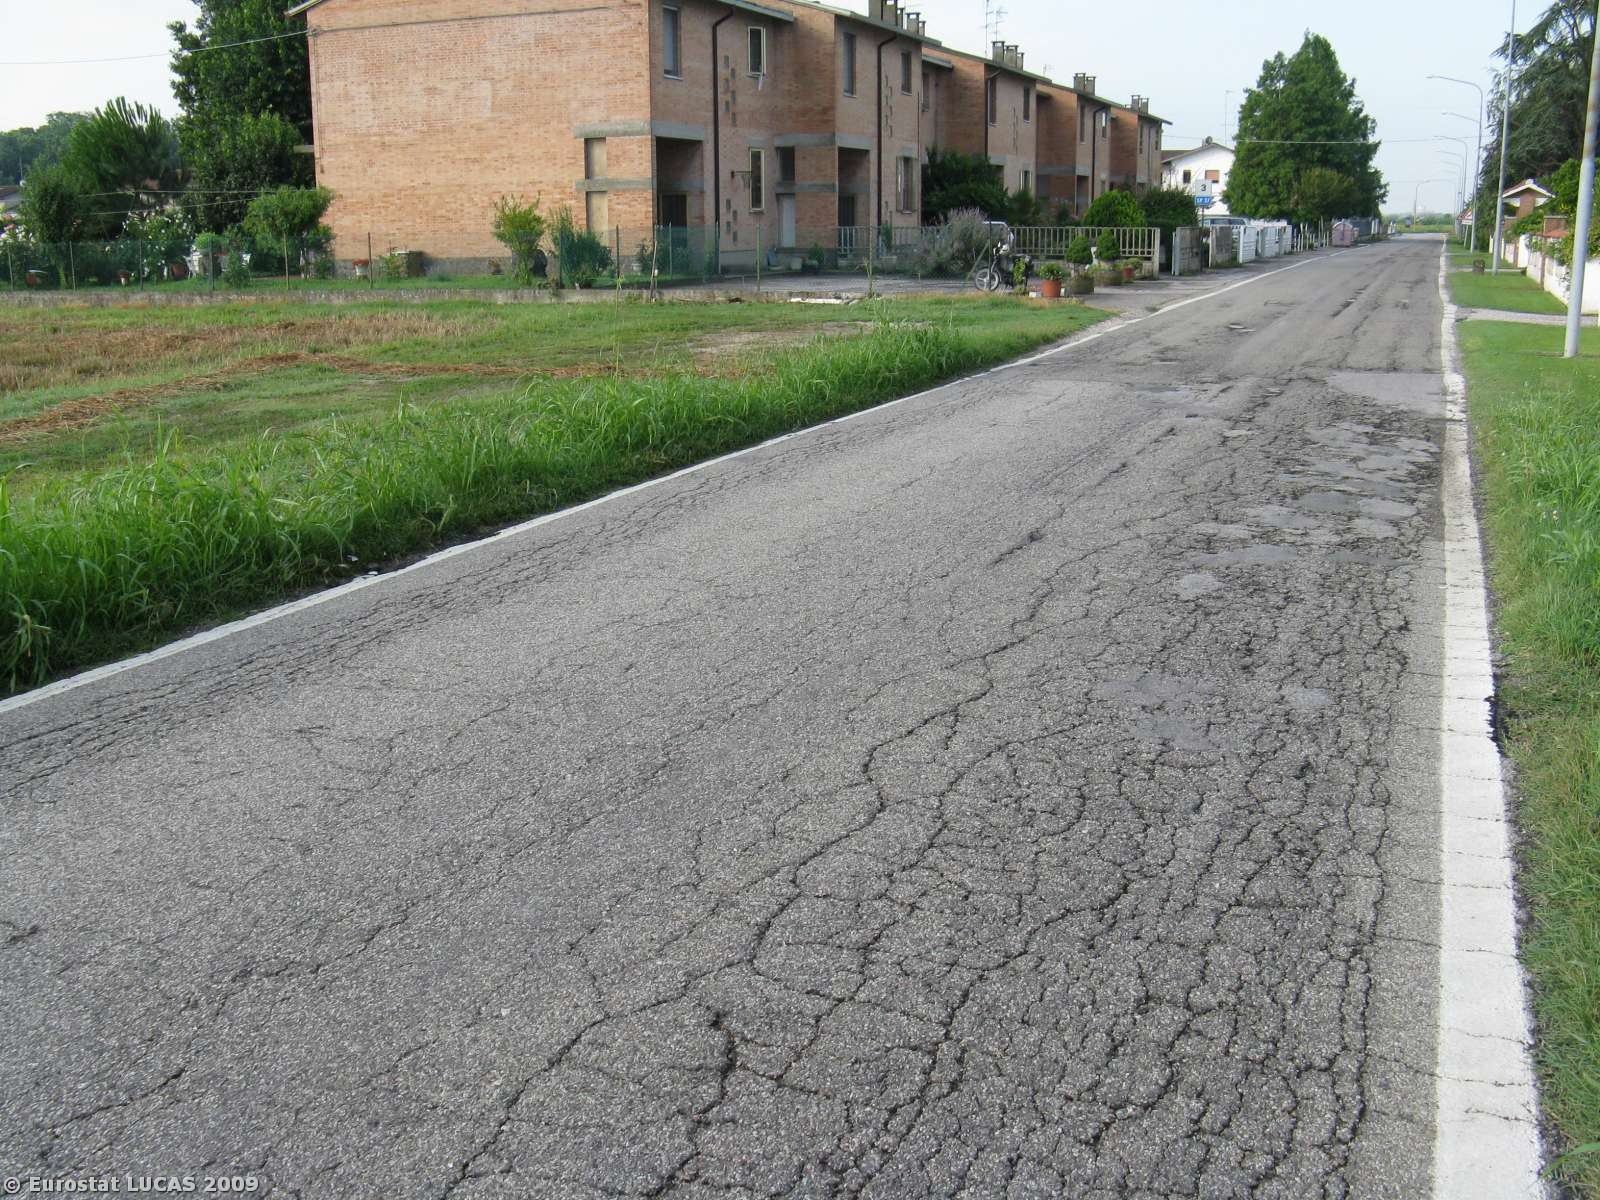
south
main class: Cropland
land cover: Maize
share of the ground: > 75 %
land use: Agriculture (excluding fallow land and kitchen gardens)
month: July
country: IT
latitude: 44.7330
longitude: 11.7265
